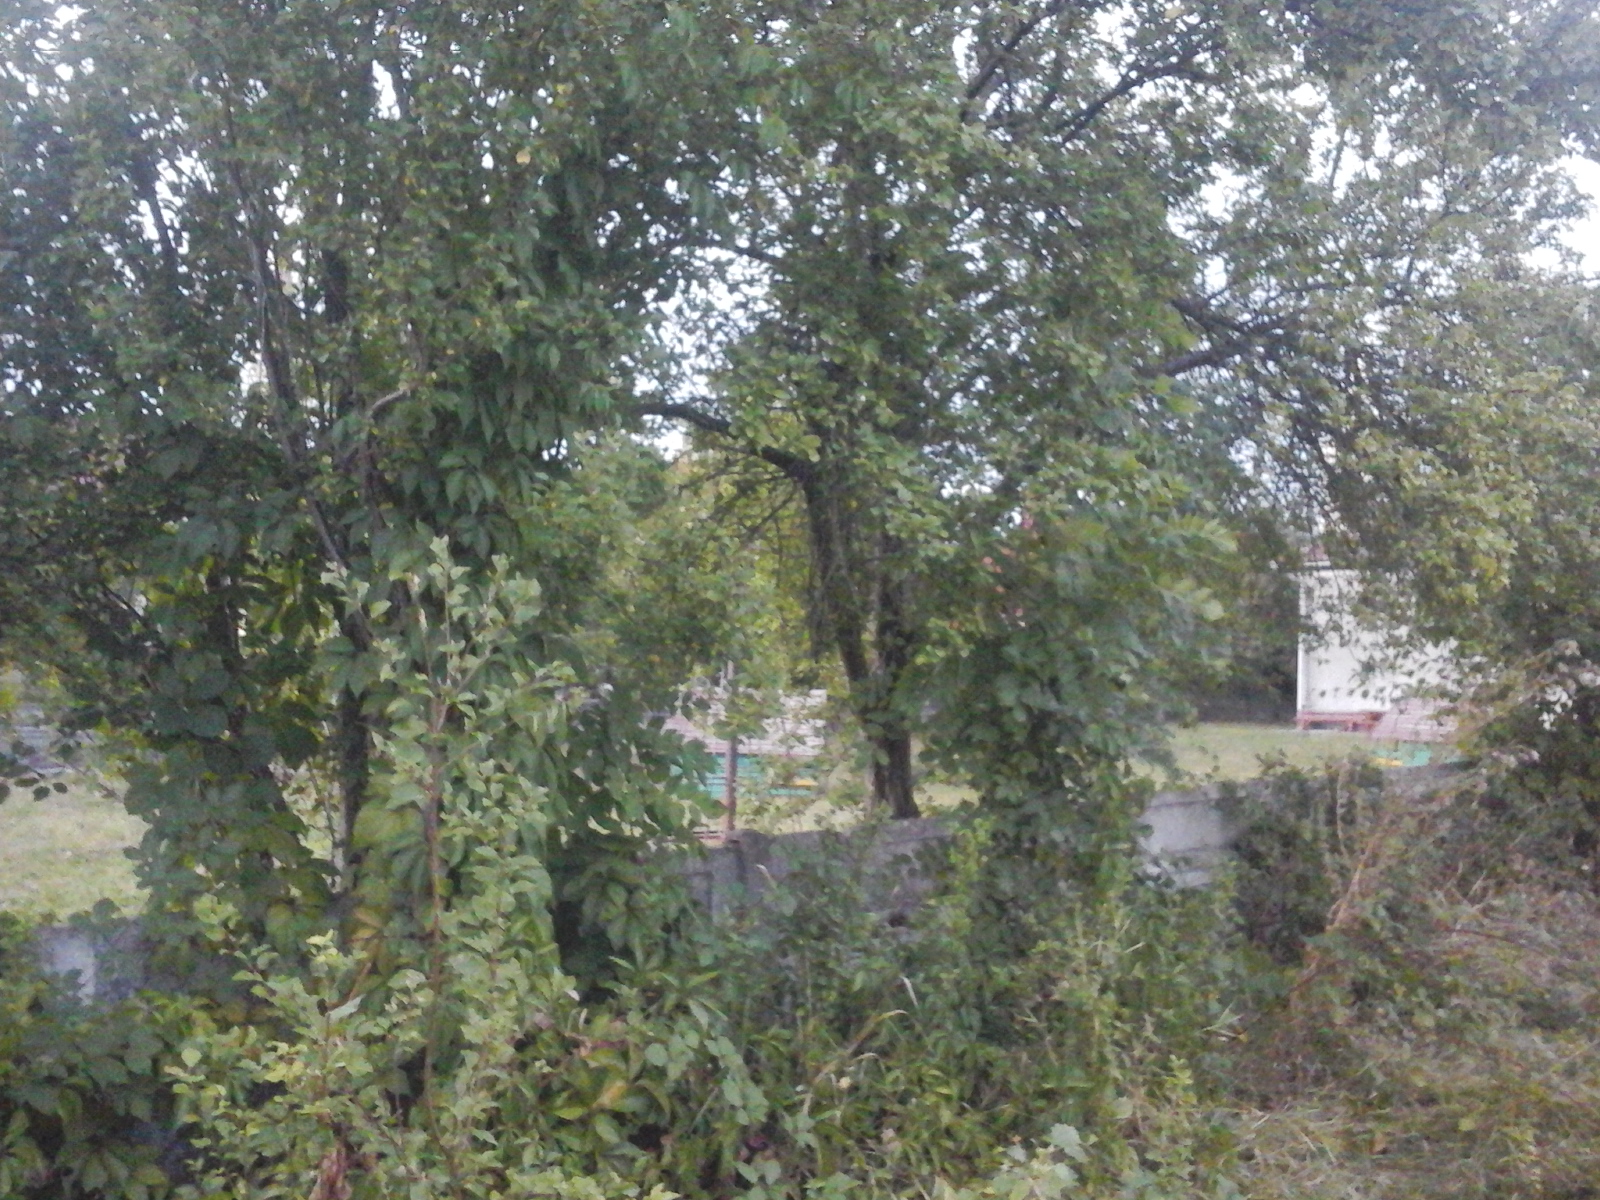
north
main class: Cropland
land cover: Other fruit trees and berries
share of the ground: > 75 %
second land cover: Grassland without tree/shrub cover
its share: > 75 %
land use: Agriculture (excluding fallow land and kitchen gardens)
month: September
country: RO
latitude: 47.5018
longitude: 23.4684
